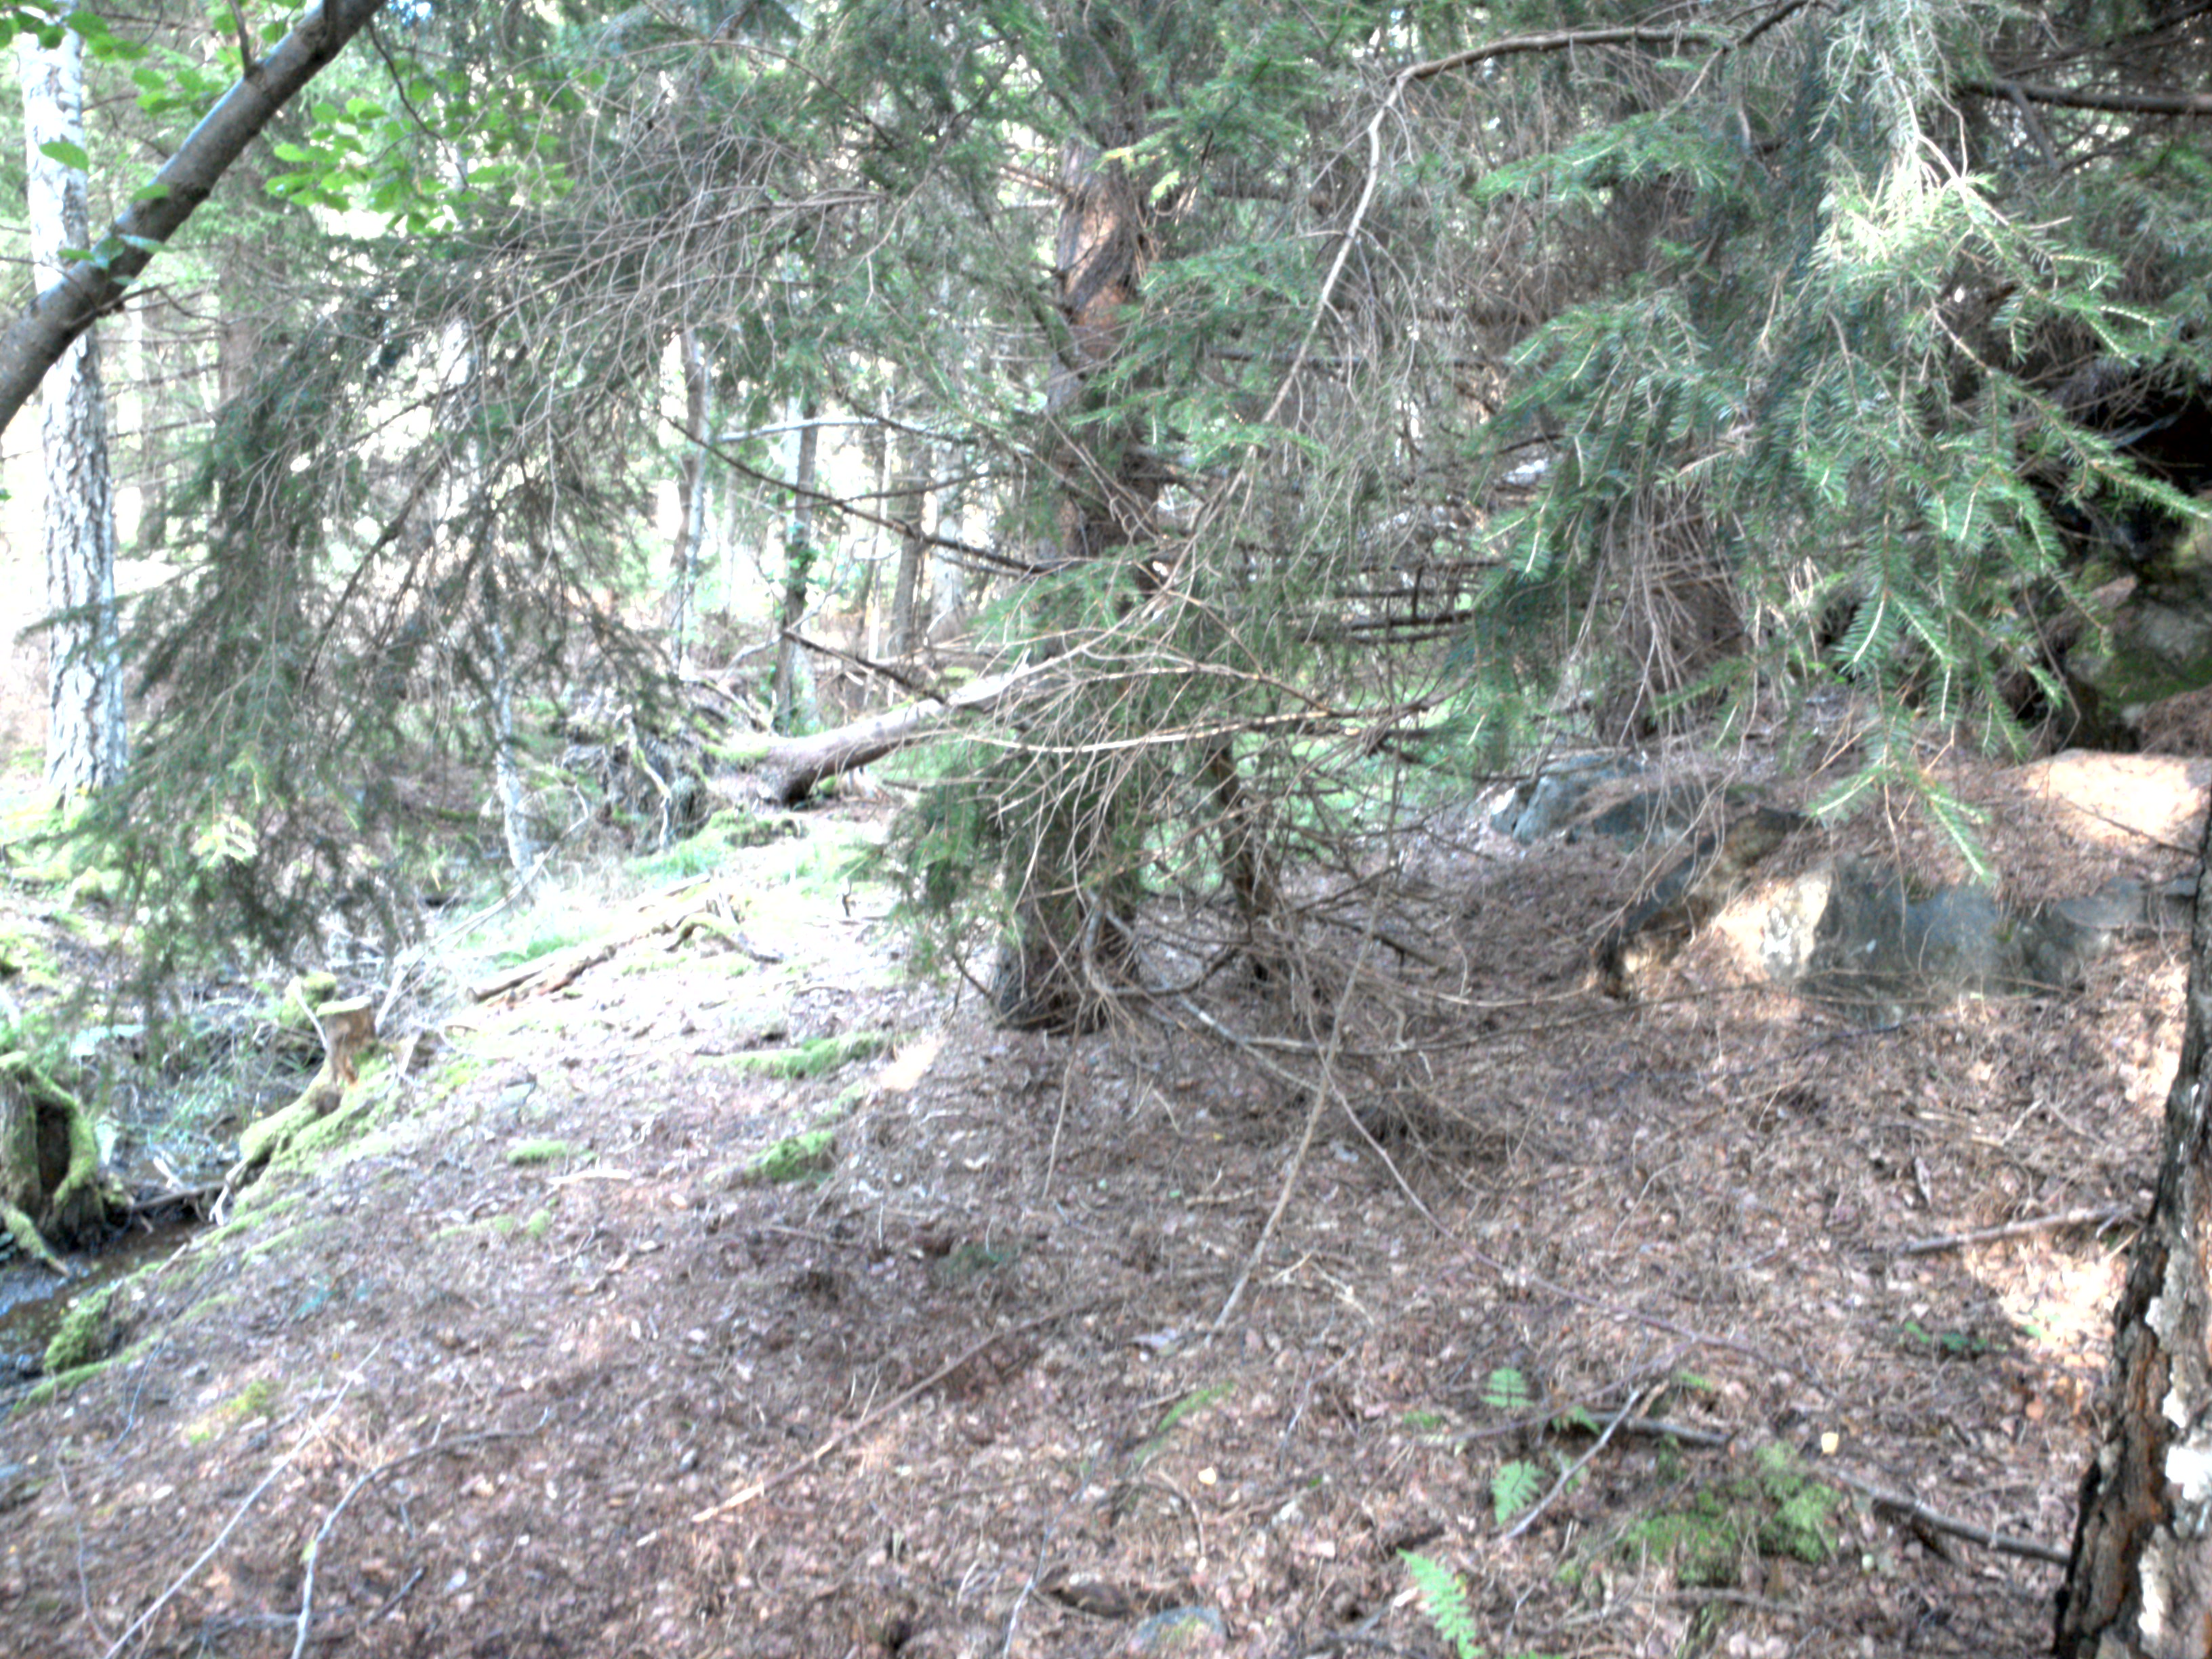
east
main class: Woodland
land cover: Spruce dominated coniferous woodland
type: boreal forest
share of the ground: > 75 %
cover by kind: coniferous forest trees 60 %, broadleaved forest trees 15 %, lichens and mosses 15 %, shrubs 10 %
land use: Forestry
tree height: > 5 m
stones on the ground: 10 - 25 %
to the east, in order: Spruce dominated coniferous woodland; Broadleaved woodland; Spruce dominated coniferous woodland; Rivers and streams; Spruce dominated coniferous woodland; Pine dominated coniferous woodland
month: July
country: SE
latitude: 59.0875
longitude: 18.2554
